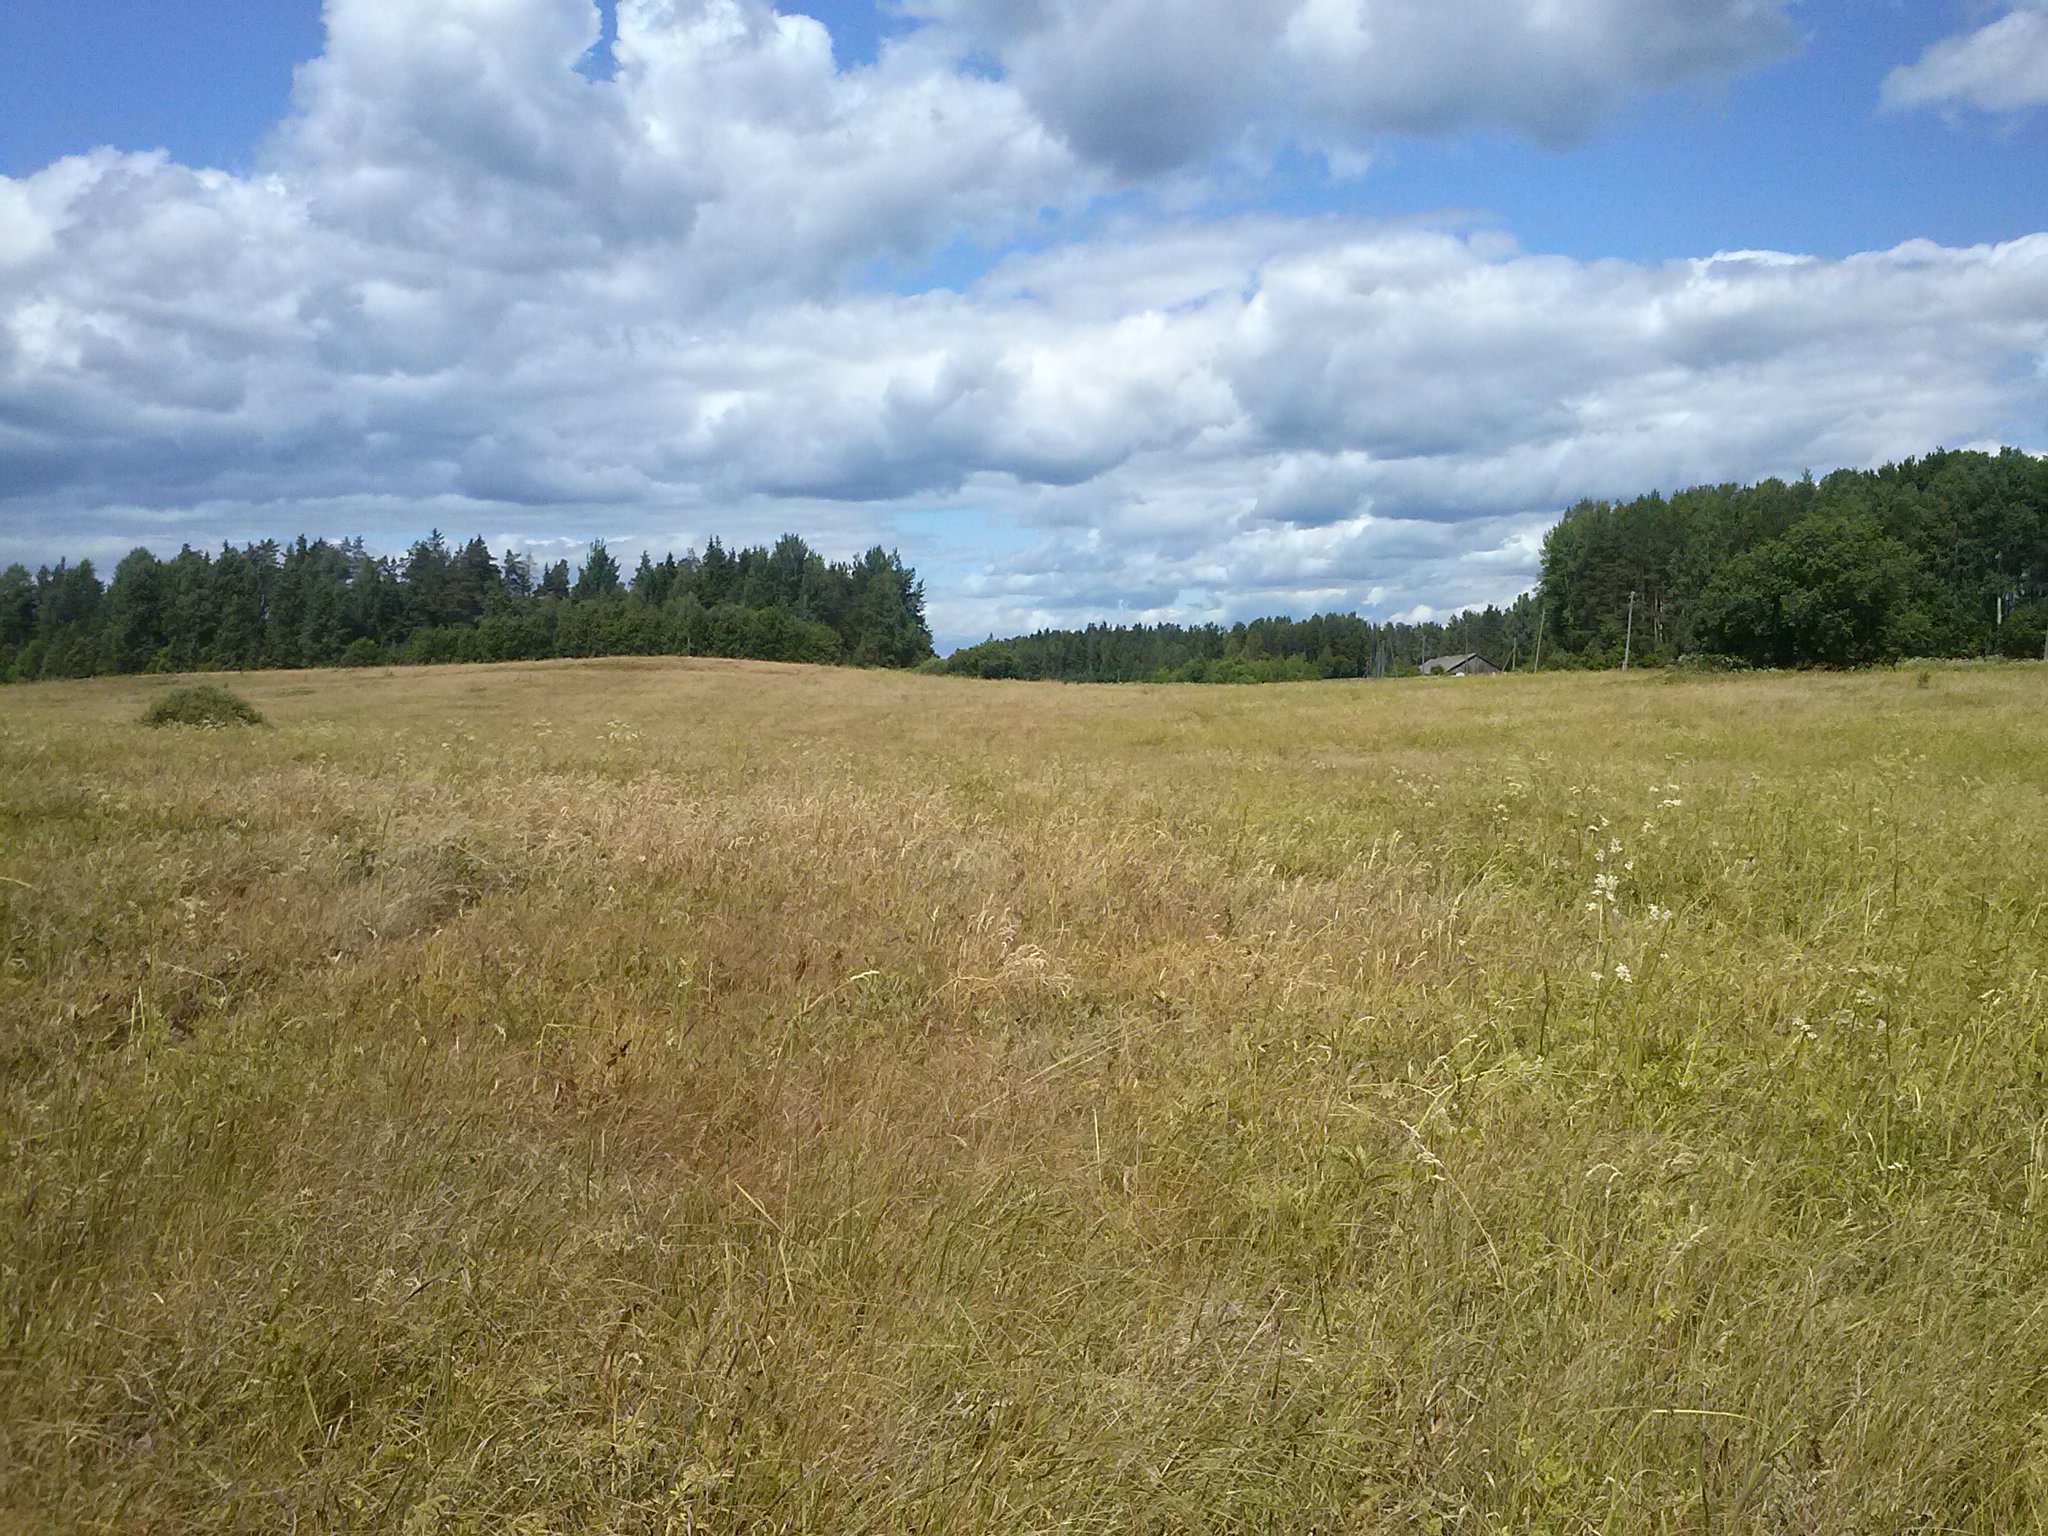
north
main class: Grassland
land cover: Grassland without tree/shrub cover
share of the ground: > 75 %
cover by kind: herbaceous plants 100 %
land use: Agriculture (excluding fallow land and kitchen gardens)
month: June
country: LV
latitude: 56.3962
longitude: 27.7335
